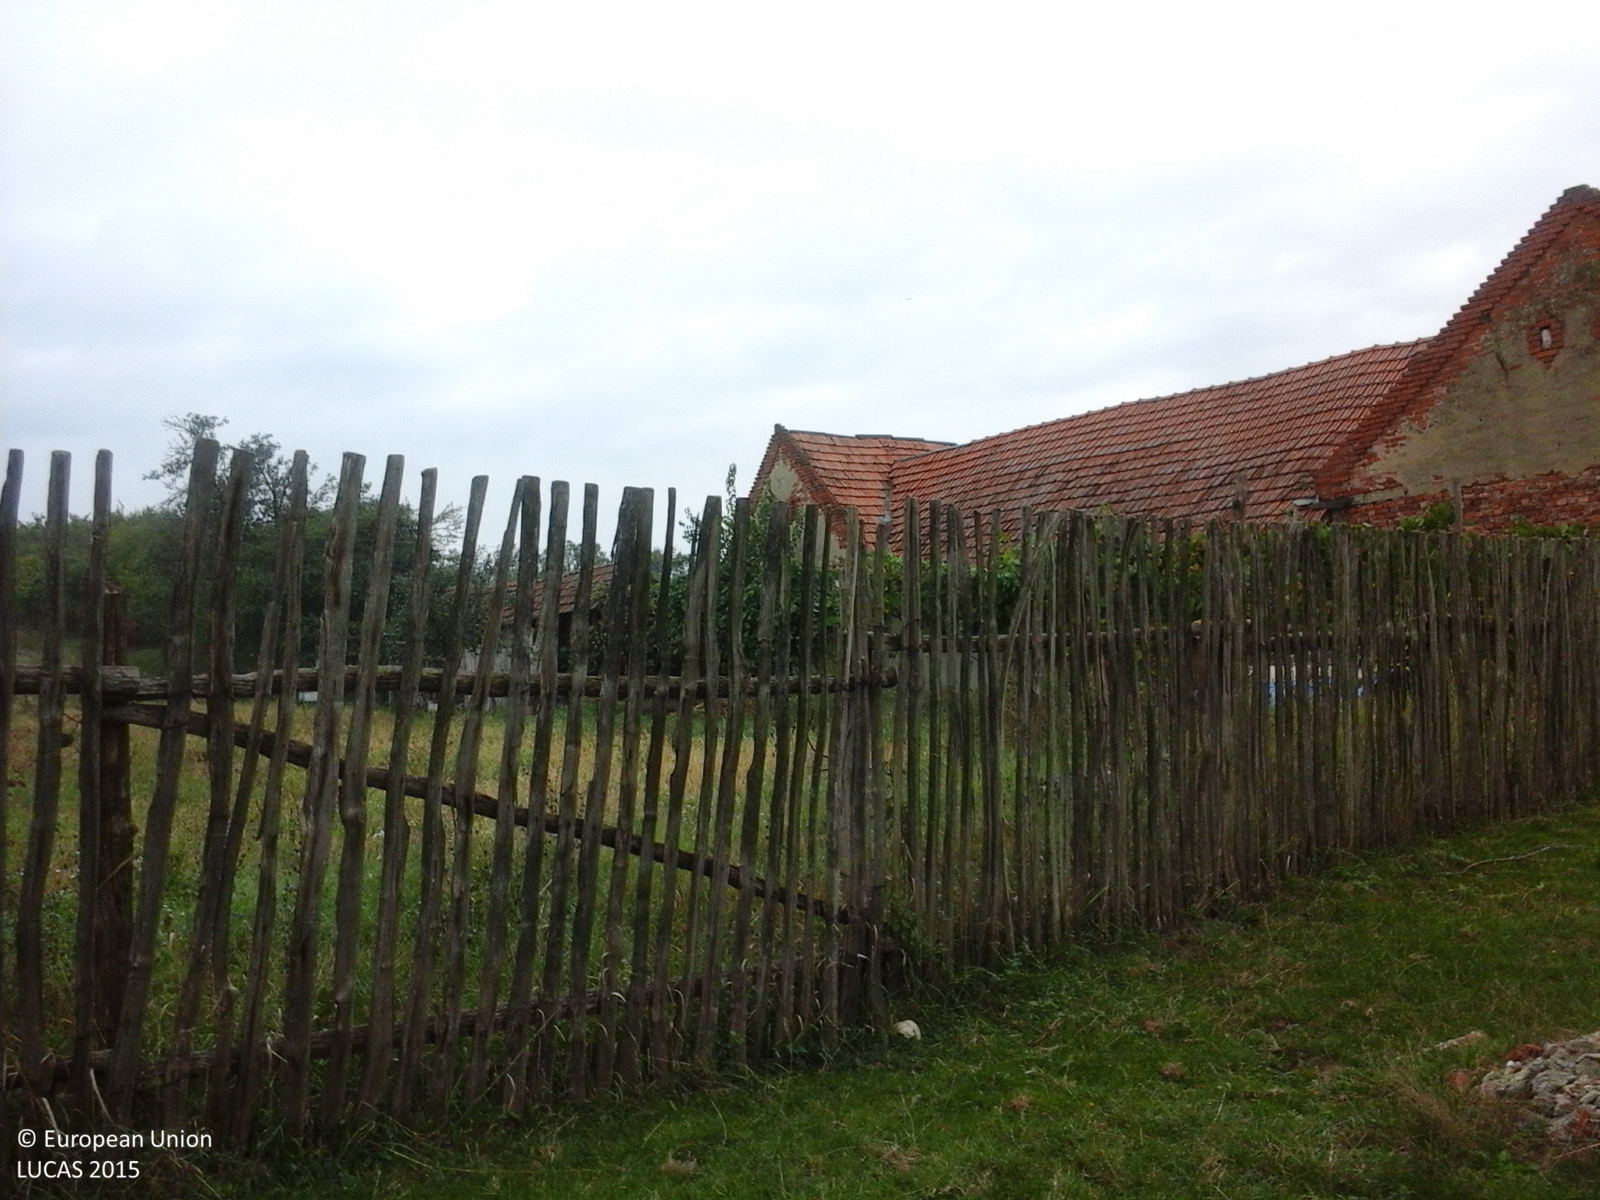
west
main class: Cropland
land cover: Apple fruit
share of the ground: > 75 %
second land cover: Grassland without tree/shrub cover
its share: > 75 %
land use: Agriculture (excluding fallow land and kitchen gardens)
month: September
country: RO
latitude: 45.6058
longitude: 21.9498
